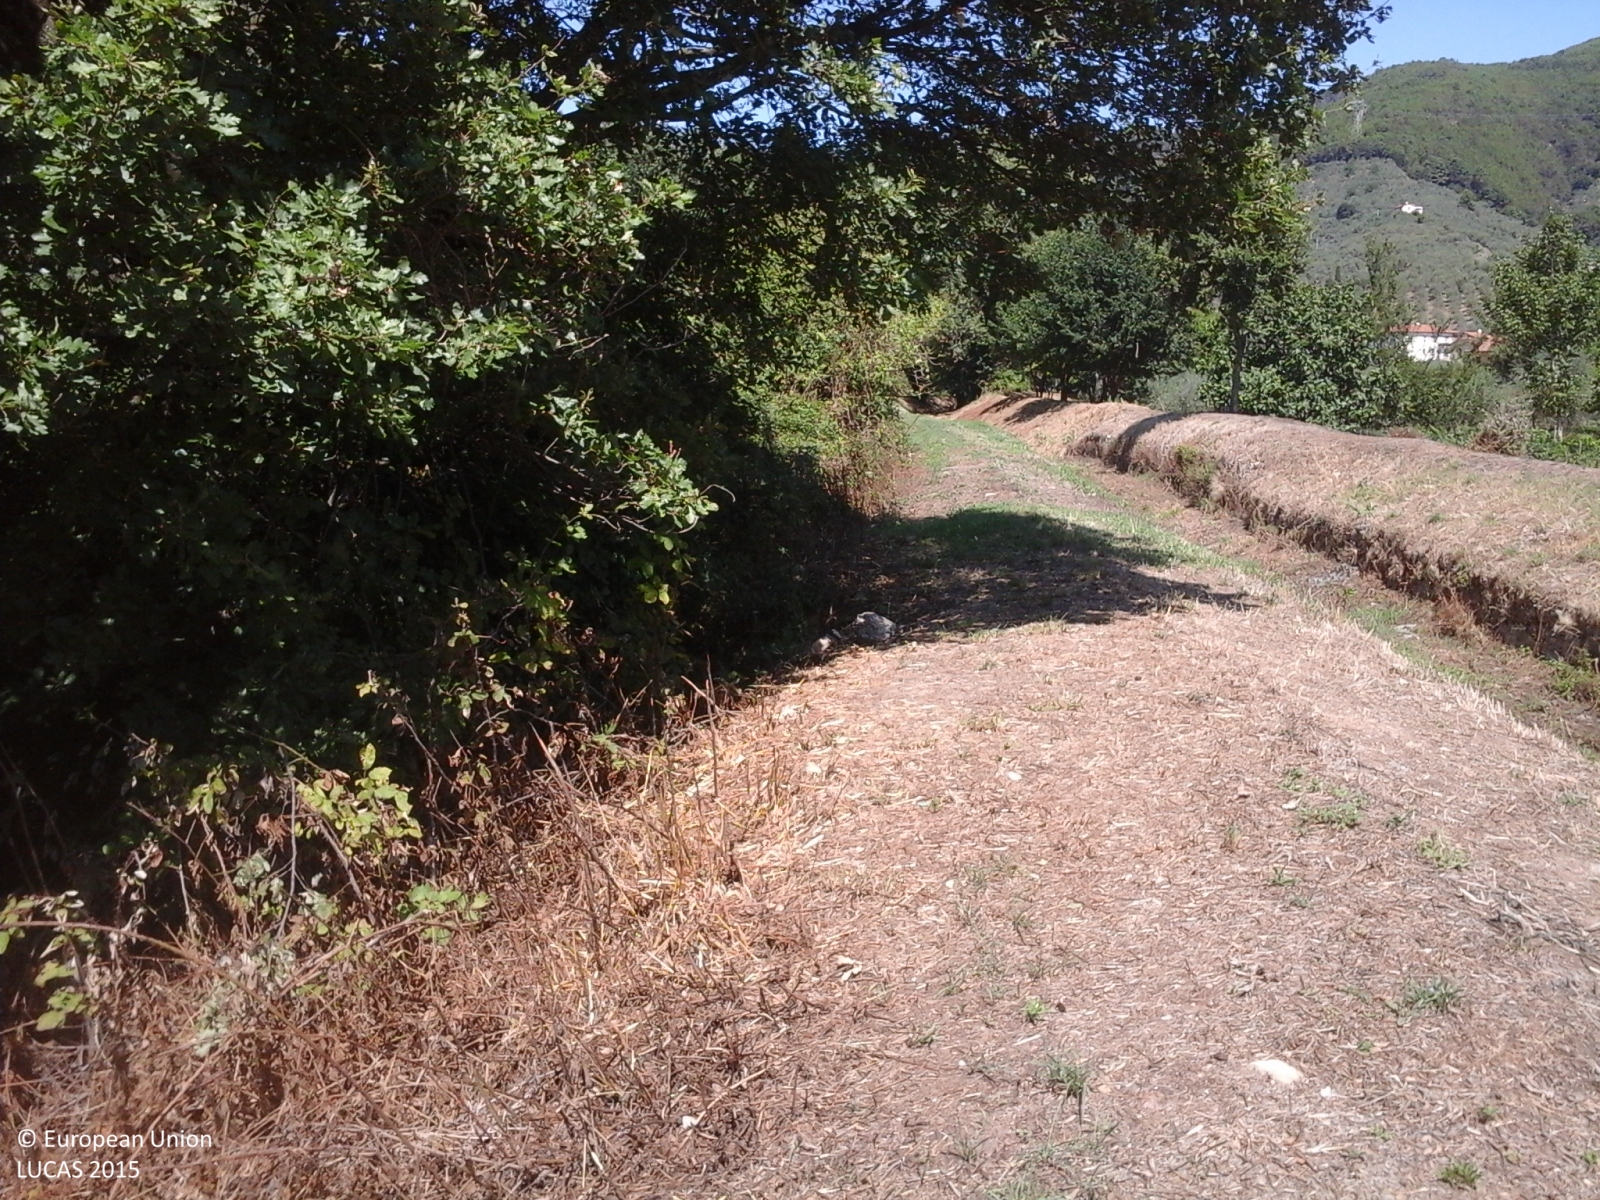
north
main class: Grassland
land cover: Grassland with sparse tree/shrub cover
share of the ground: > 75 %
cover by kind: herbaceous plants 85 %, shrubs 10 %, broadleaved forest trees 5 %
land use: Semi-natural and natural areas not in use
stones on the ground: < 10 %
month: August
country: IT
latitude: 43.7542
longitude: 10.4583
